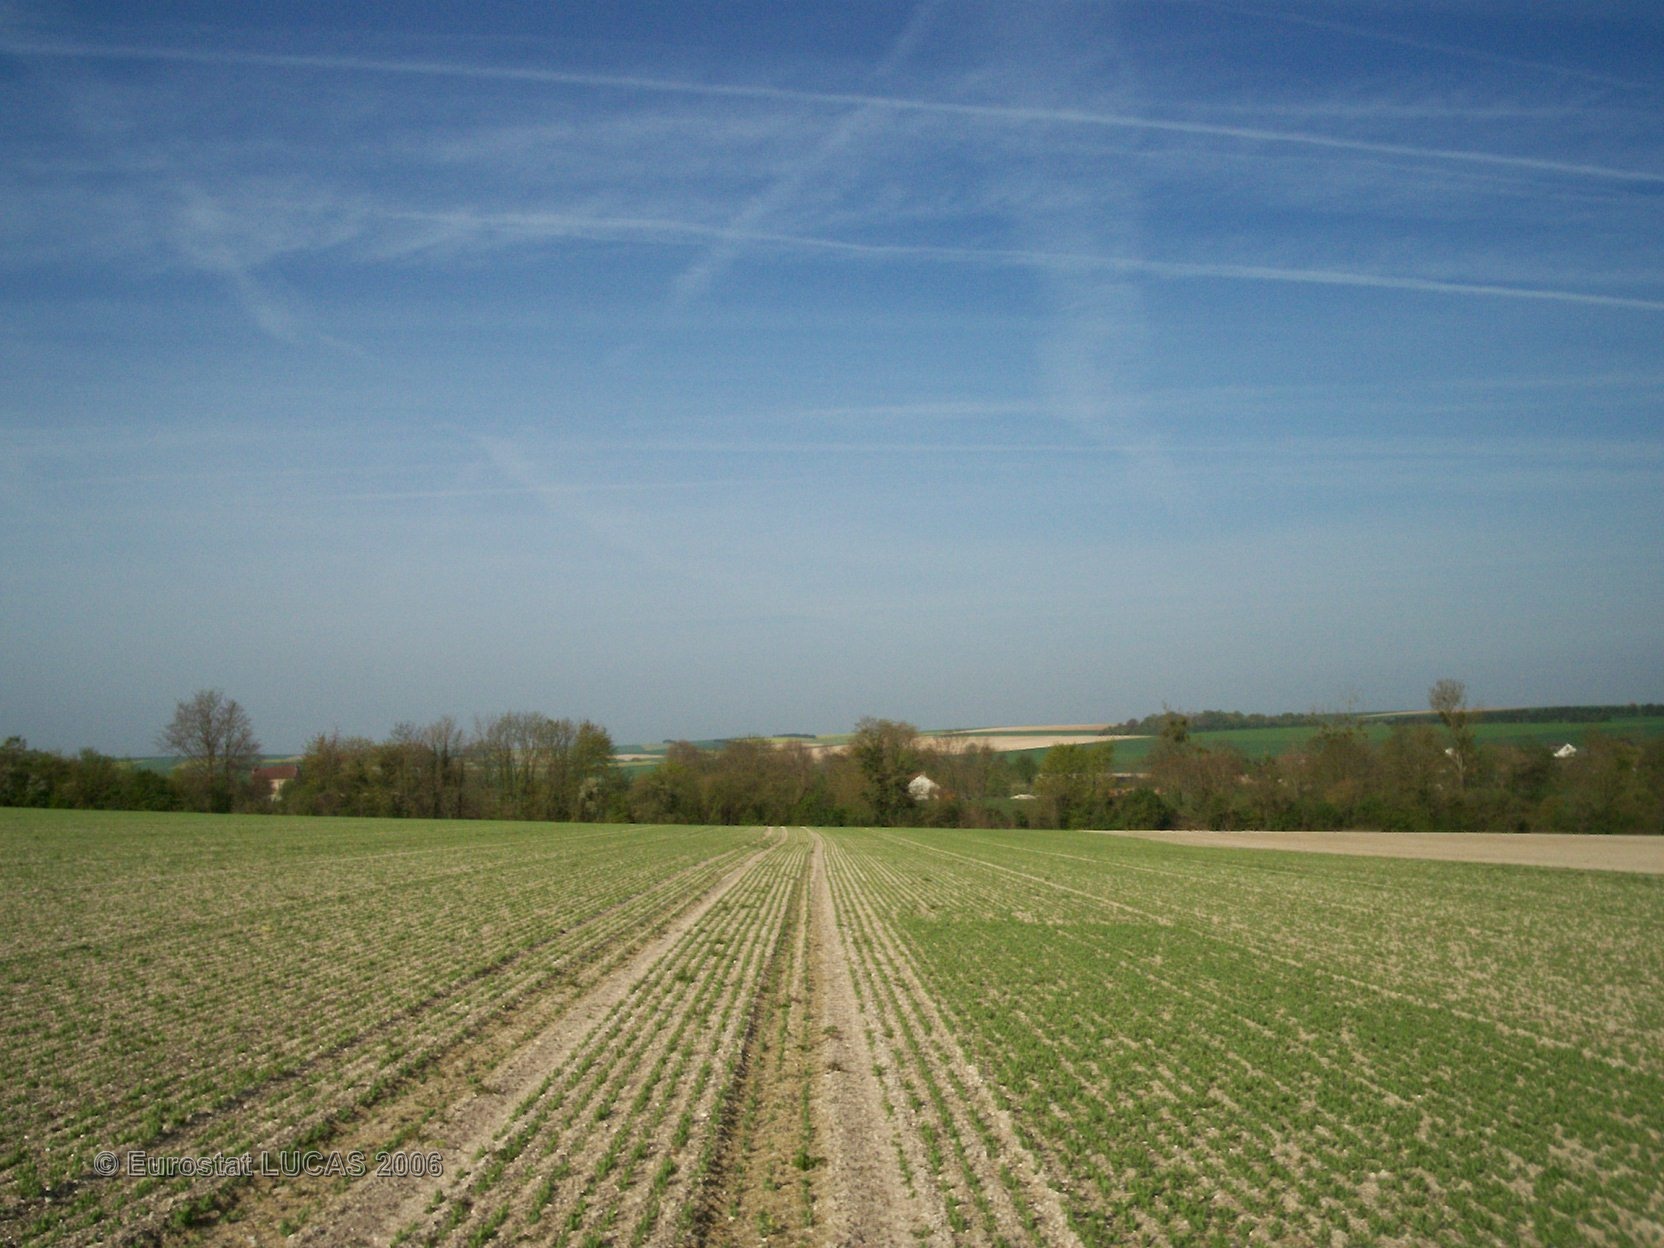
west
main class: Cropland
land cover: Dry pulses
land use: Agriculture (excluding fallow land and kitchen gardens)
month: May
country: FR
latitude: 48.7848
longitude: 4.4028
